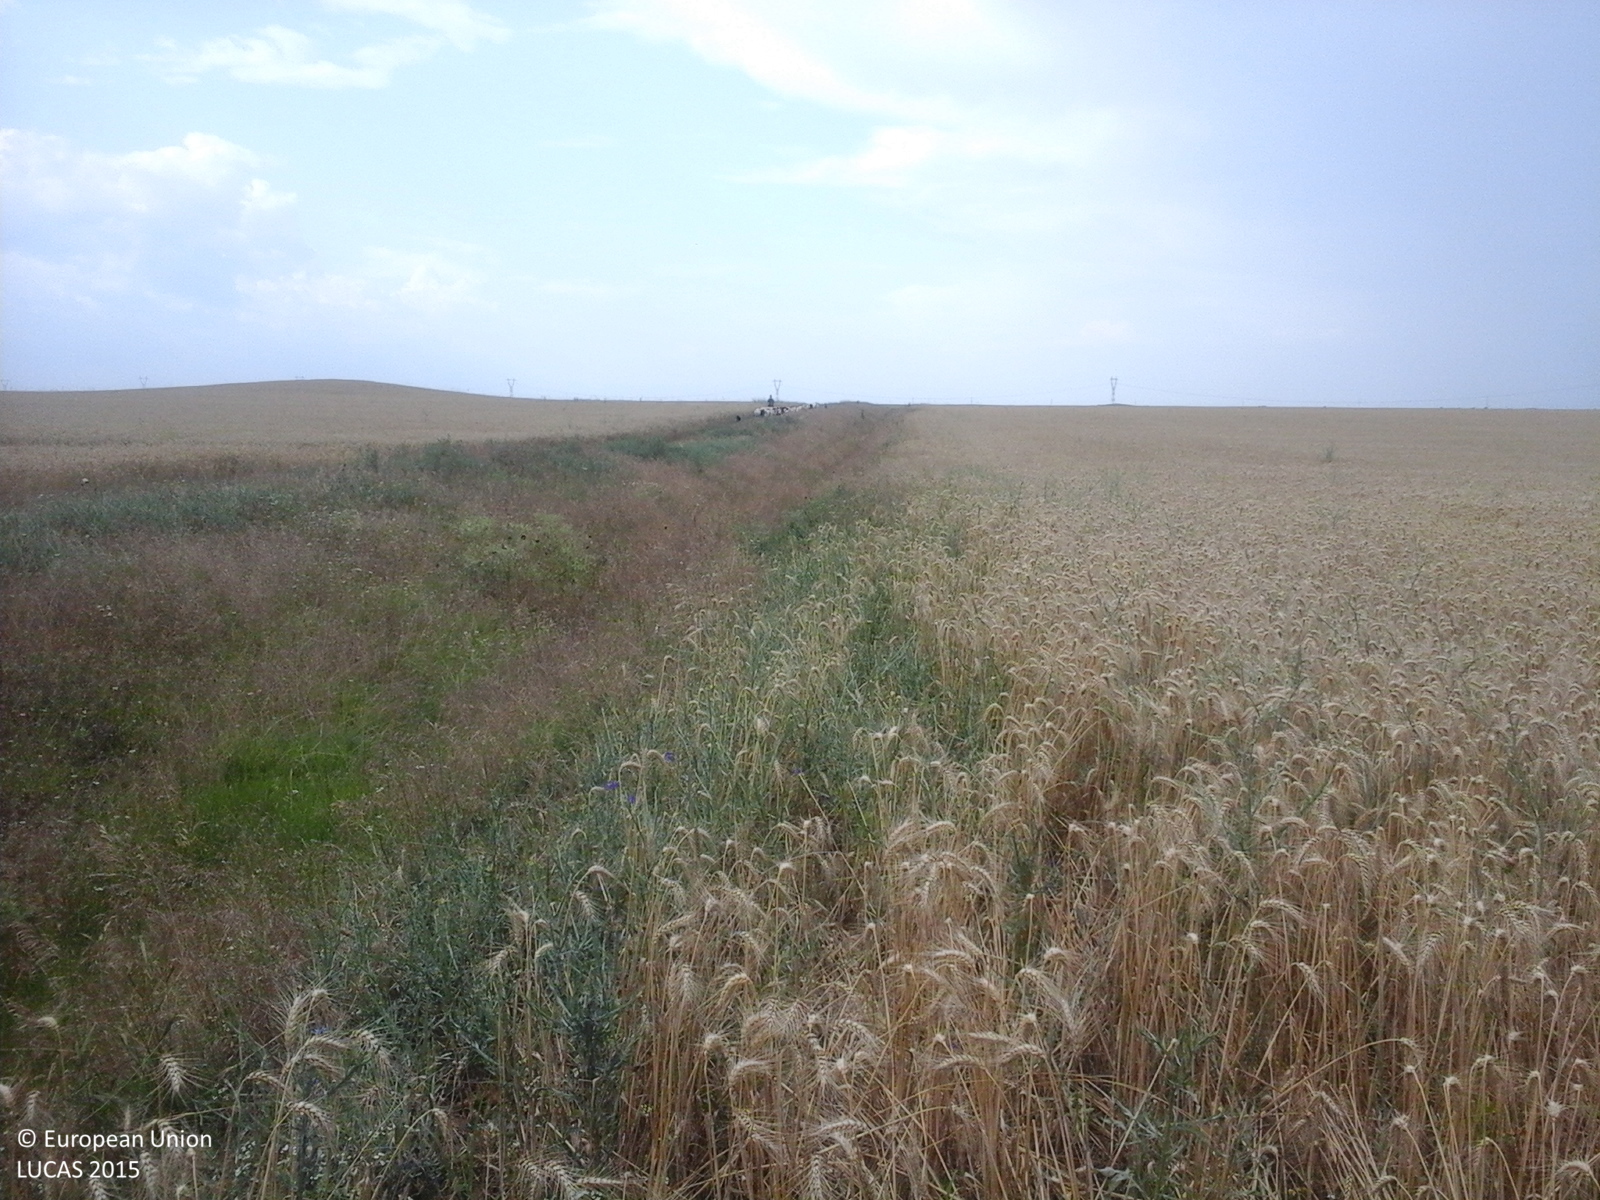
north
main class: Cropland
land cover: Common wheat
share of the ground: > 75 %
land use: Agriculture (excluding fallow land and kitchen gardens)
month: July
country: RO
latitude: 43.9678
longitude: 24.3599
